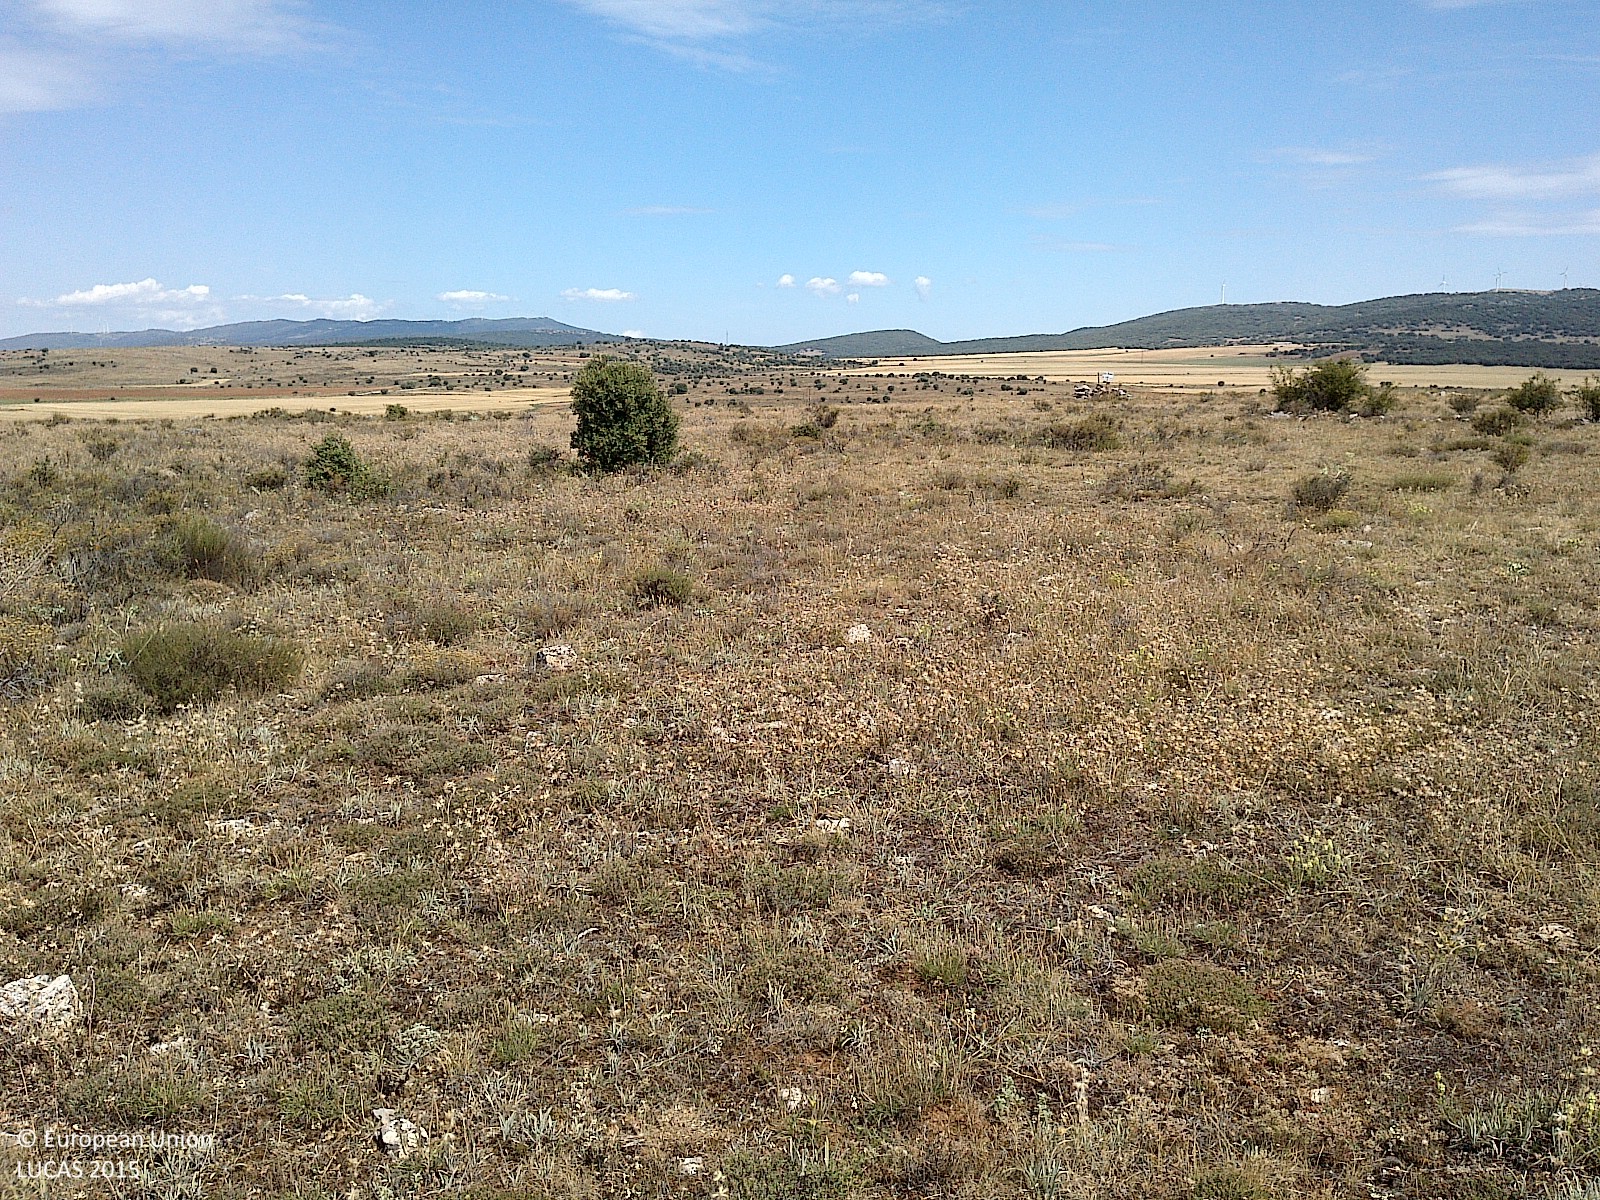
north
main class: Grassland
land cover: Grassland without tree/shrub cover
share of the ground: 50 - 75 %
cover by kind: herbaceous plants 70 %, lichens and mosses 25 %, shrubs 5 %
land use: Agriculture (excluding fallow land and kitchen gardens)
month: July
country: ES
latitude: 41.7291
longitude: -2.0672
